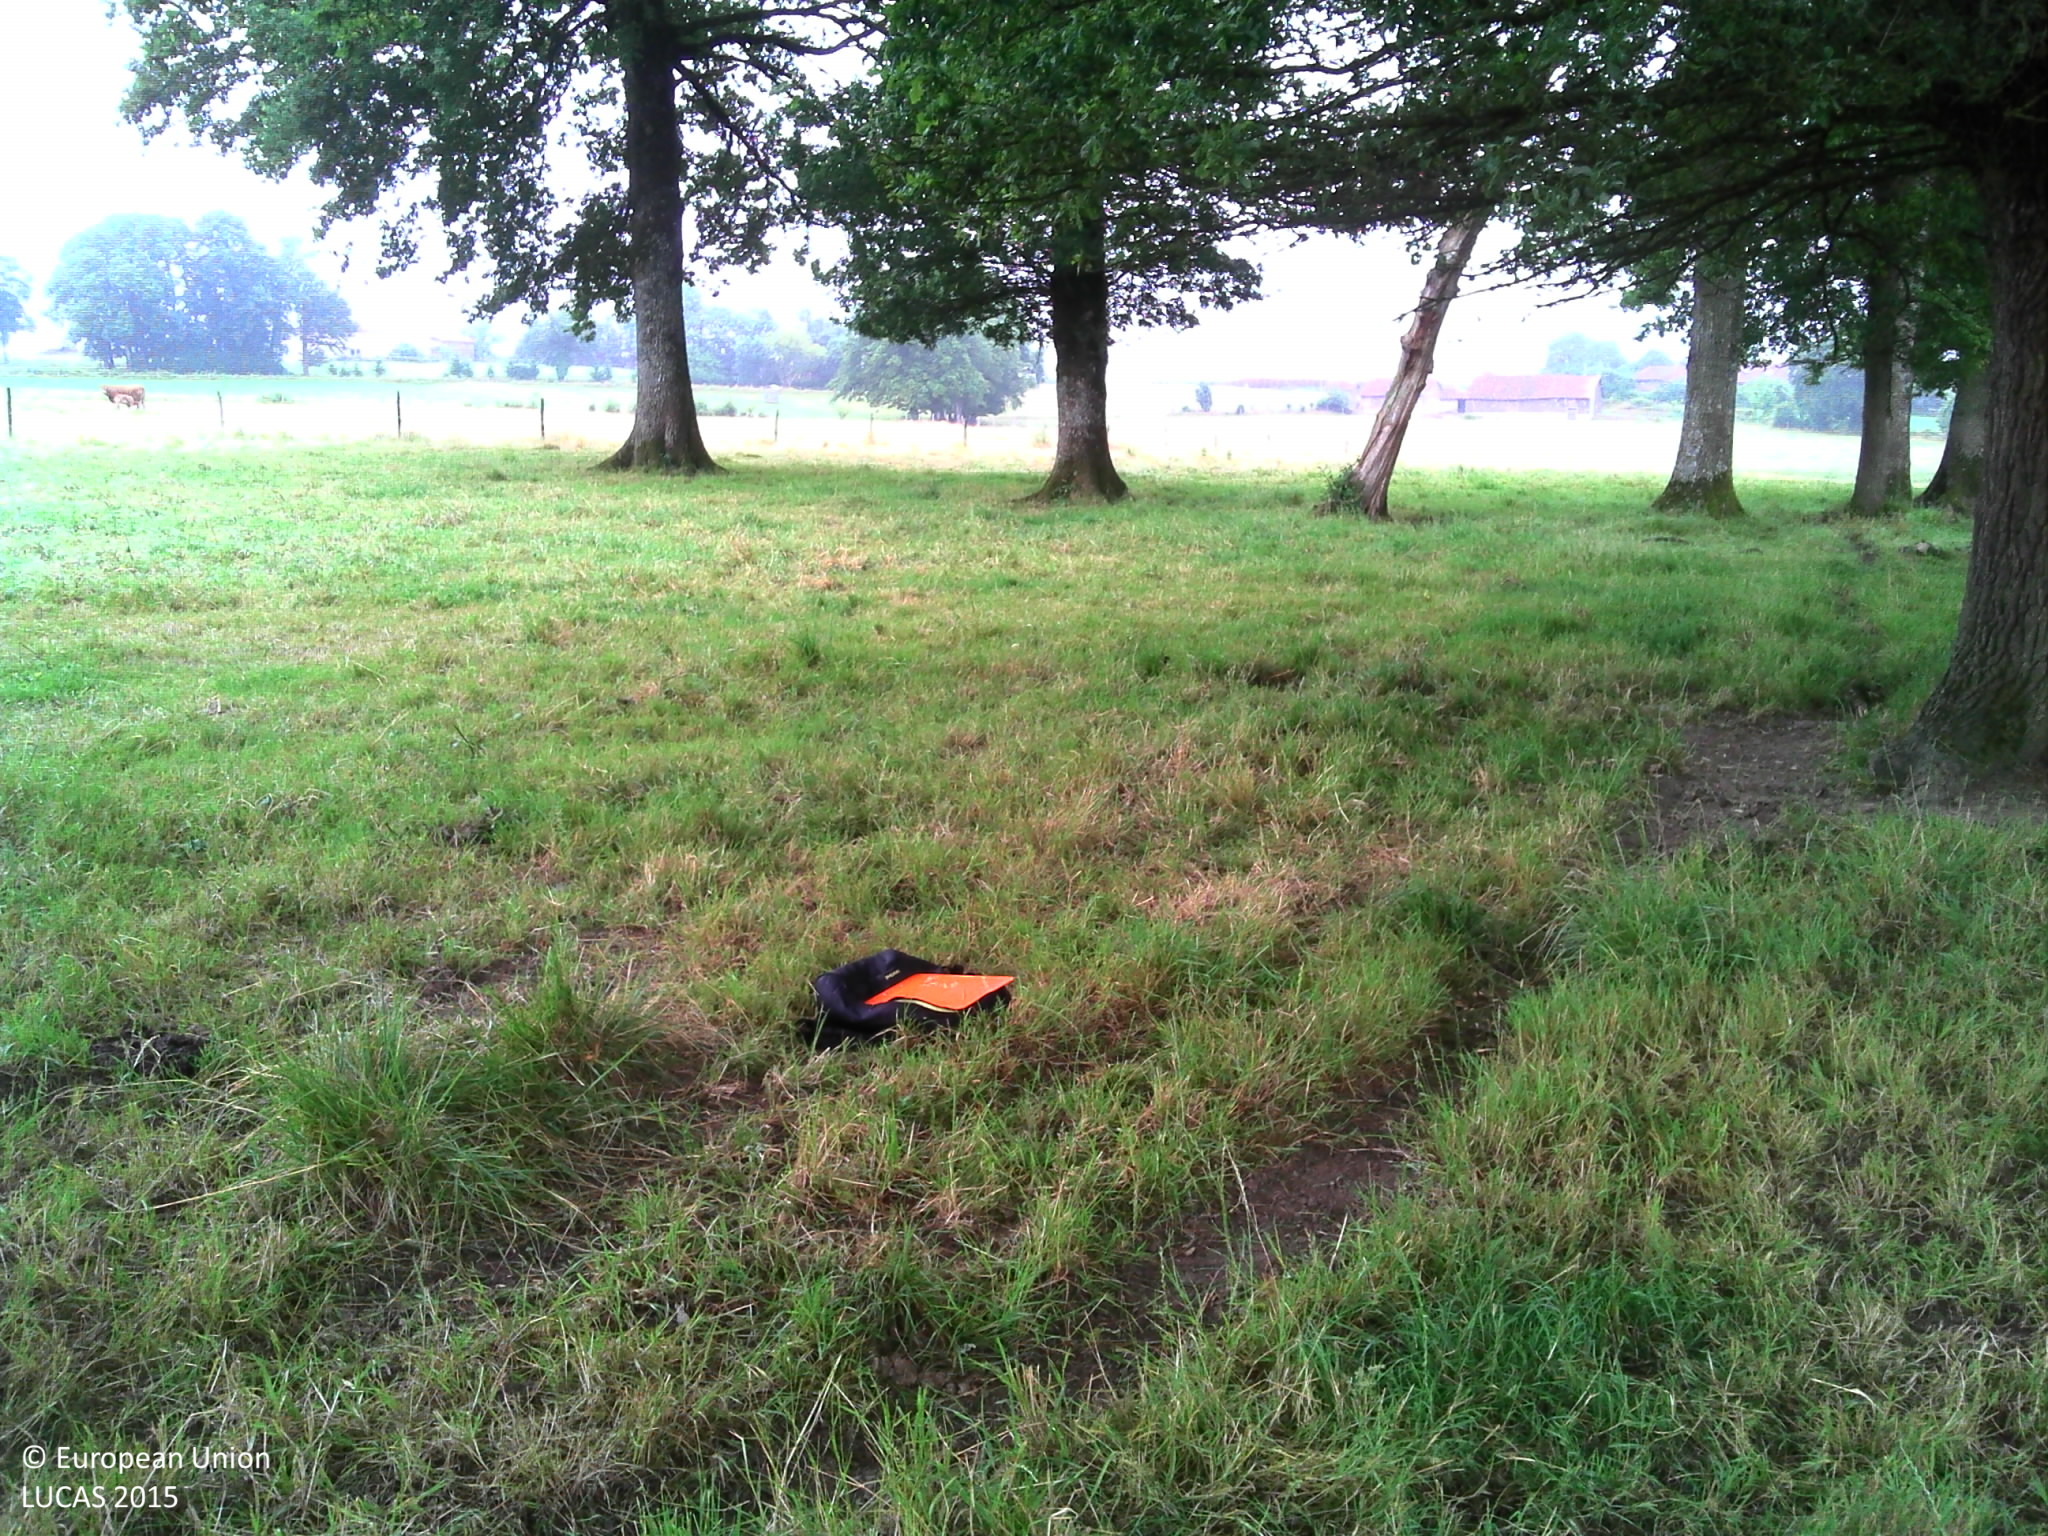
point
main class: Grassland
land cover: Grassland with sparse tree/shrub cover
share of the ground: > 75 %
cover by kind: herbaceous plants 95 %, coniferous forest trees 5 %
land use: Agriculture (excluding fallow land and kitchen gardens)
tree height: > 5 m
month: June
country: FR
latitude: 45.7899
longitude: 0.5828
